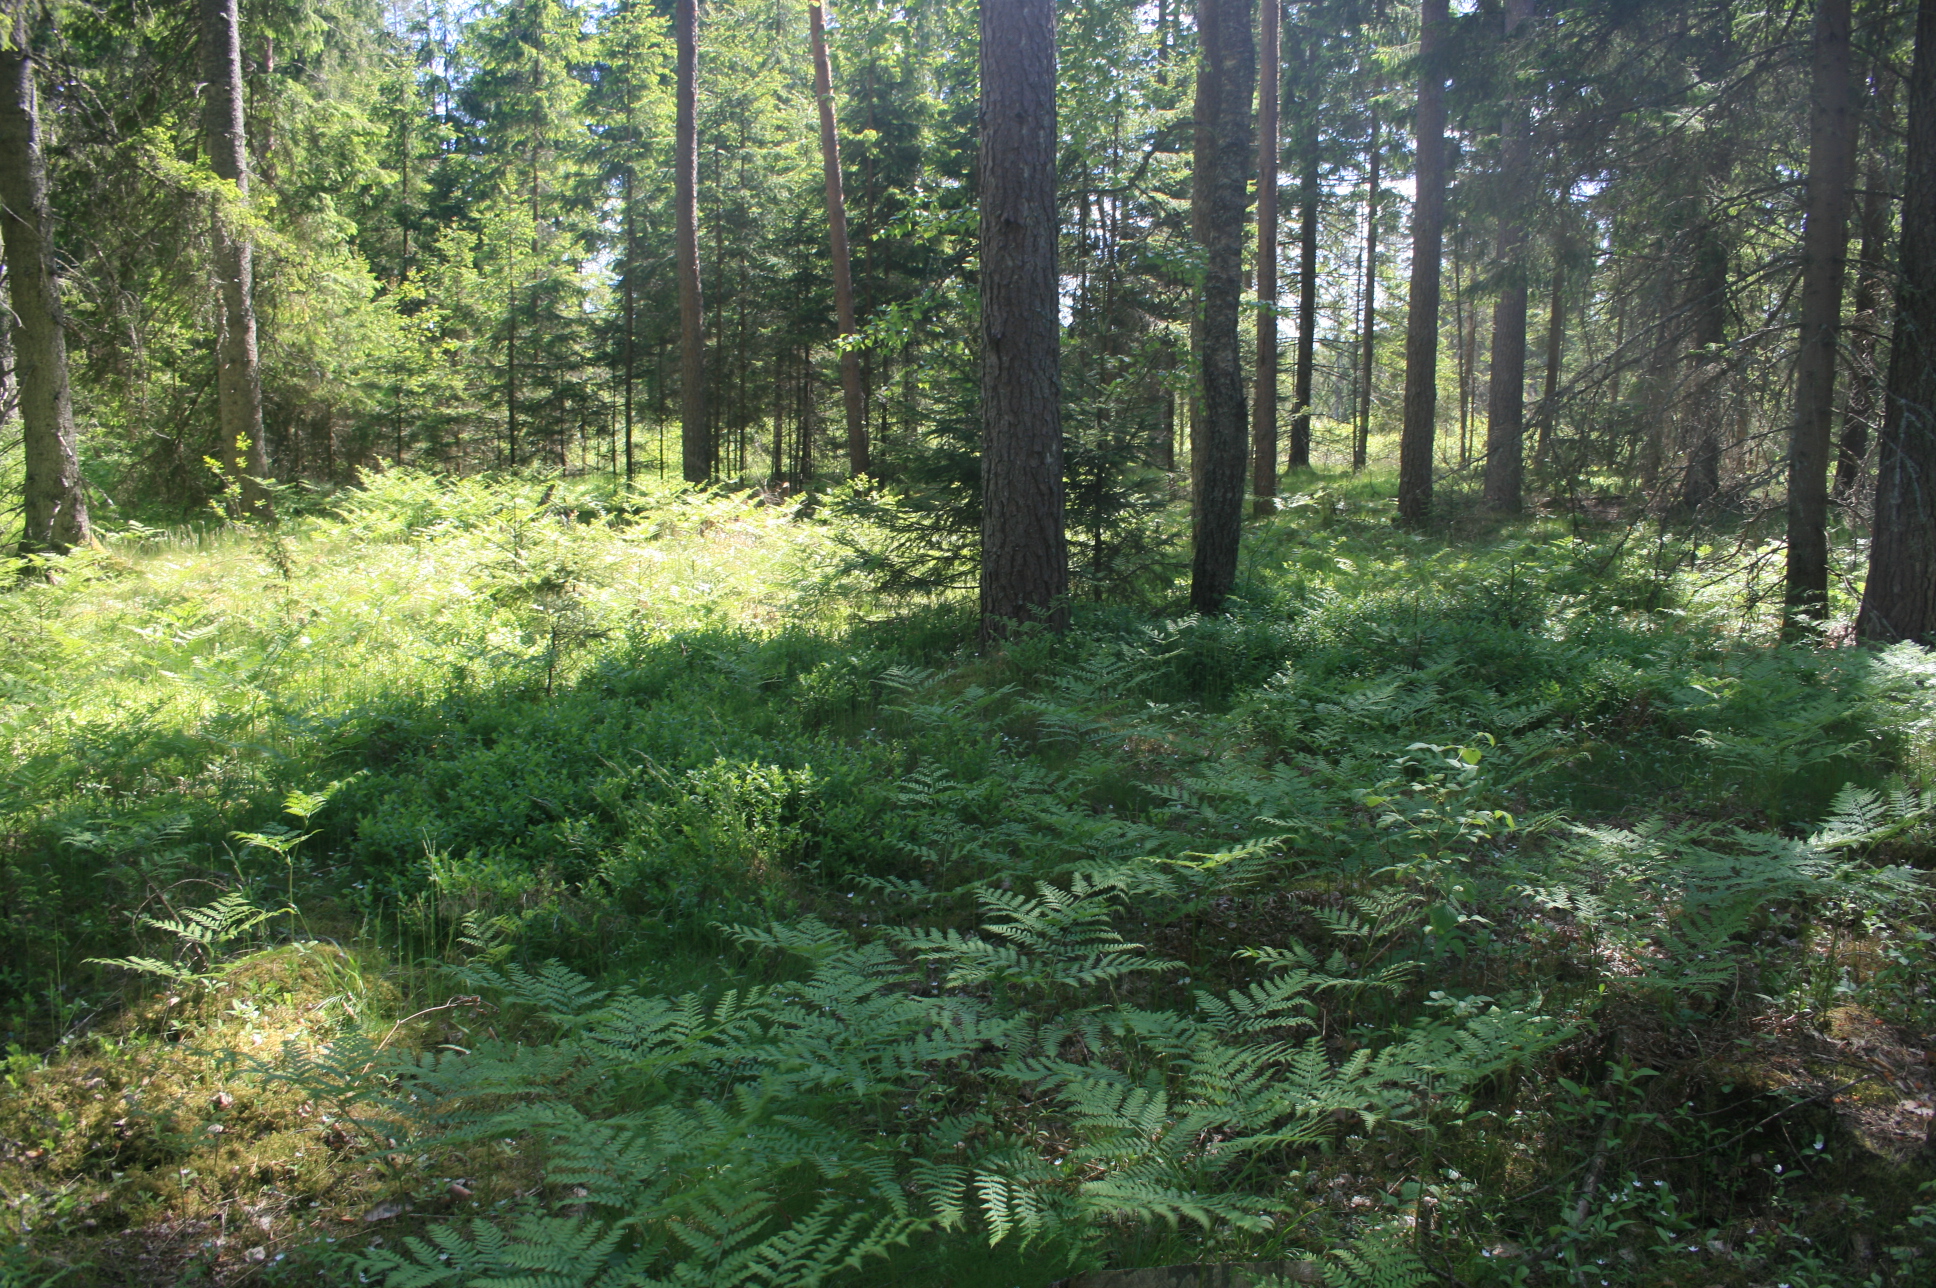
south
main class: Woodland
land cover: Spruce dominated coniferous woodland
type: hemiboreal forest and nemoral coniferous forest and mixed broadleaved-coniferous forest
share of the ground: > 75 %
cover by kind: coniferous forest trees 85 %, broadleaved forest trees 10 %, herbaceous plants 5 %
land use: Forestry
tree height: > 5 m
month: June
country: LT
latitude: 55.7976
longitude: 22.2588
